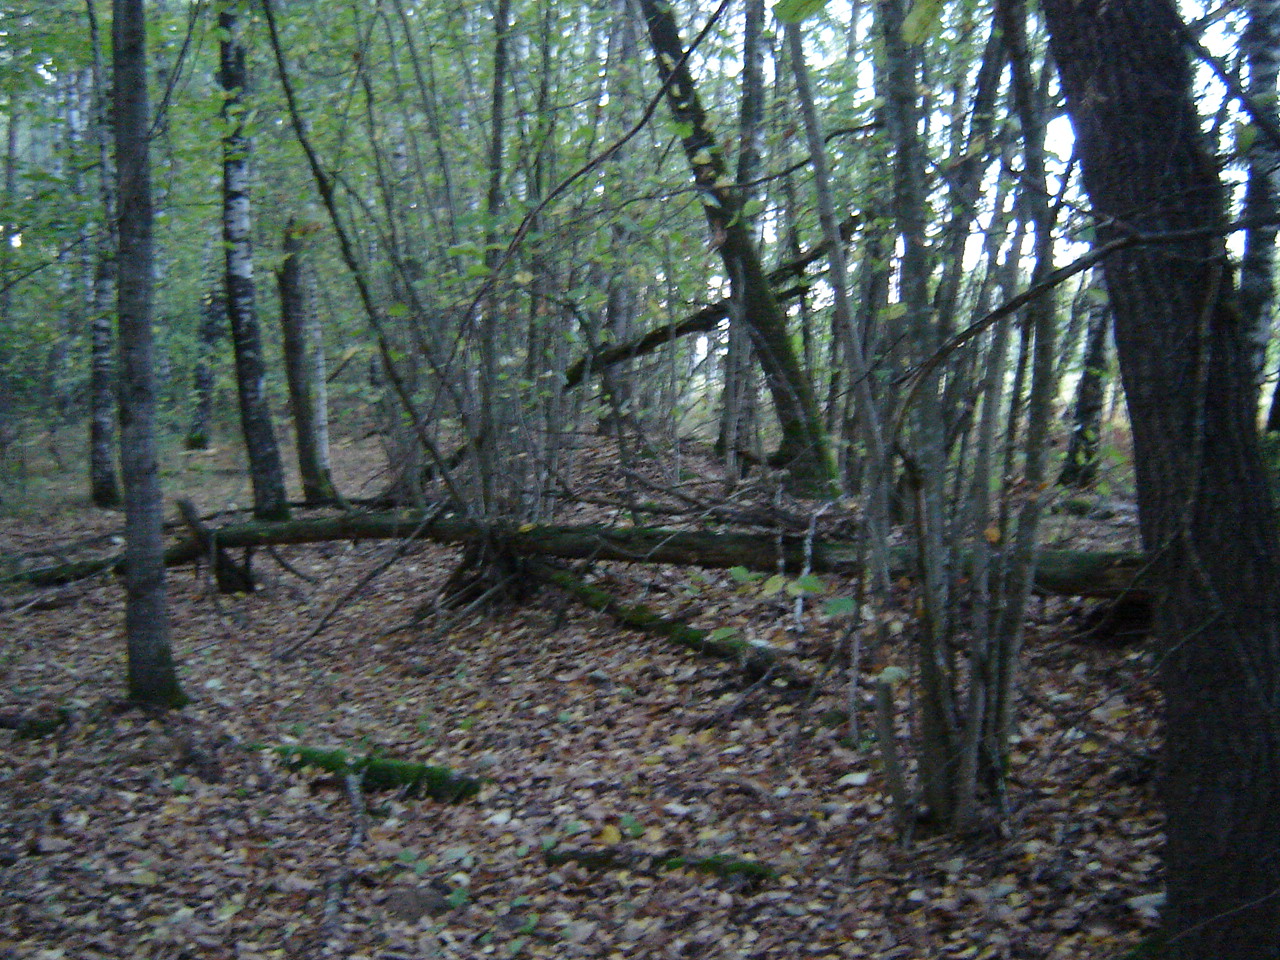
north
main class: Woodland
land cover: Broadleaved woodland
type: non-riverine alder, birch or aspen forest
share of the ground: > 75 %
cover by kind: broadleaved forest trees 80 %, coniferous forest trees 10 %, herbaceous plants 5 %, unconsolidated bare surface 5 %
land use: Forestry
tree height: > 5 m
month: September
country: LT
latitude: 54.2521
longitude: 25.0193
